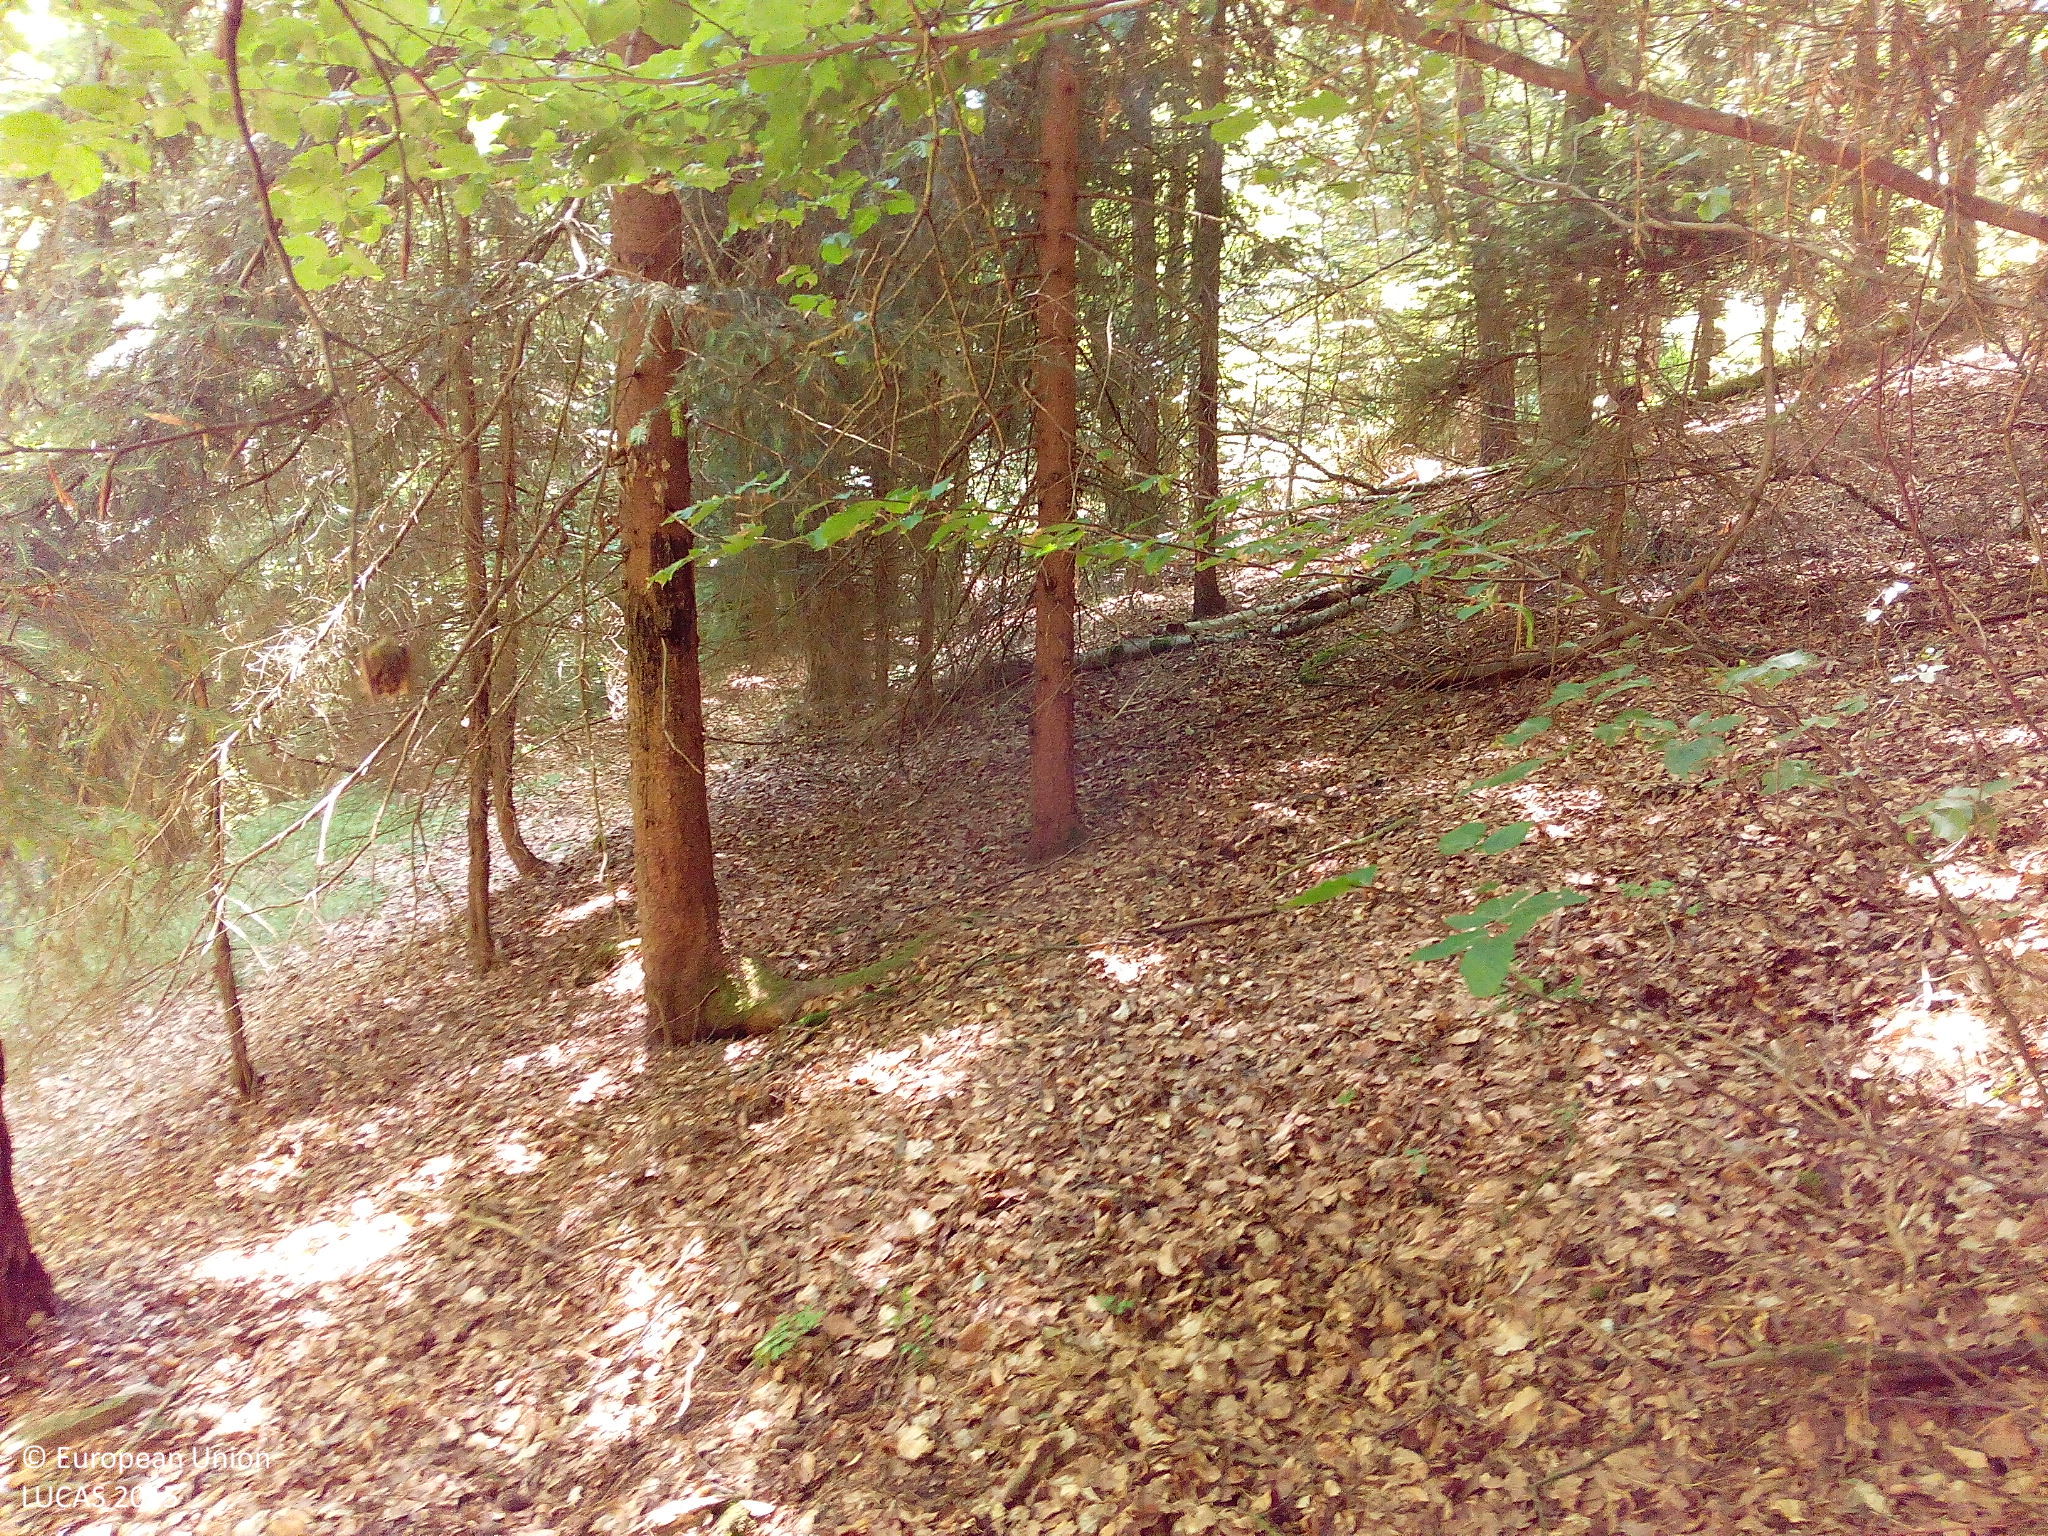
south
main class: Woodland
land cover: Pine dominated mixed woodland
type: hemiboreal forest and nemoral coniferous forest and mixed broadleaved-coniferous forest
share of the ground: > 75 %
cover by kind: coniferous forest trees 50 %, broadleaved forest trees 50 %
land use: Forestry
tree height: > 5 m
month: July
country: DE
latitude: 50.9214
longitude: 9.9573
